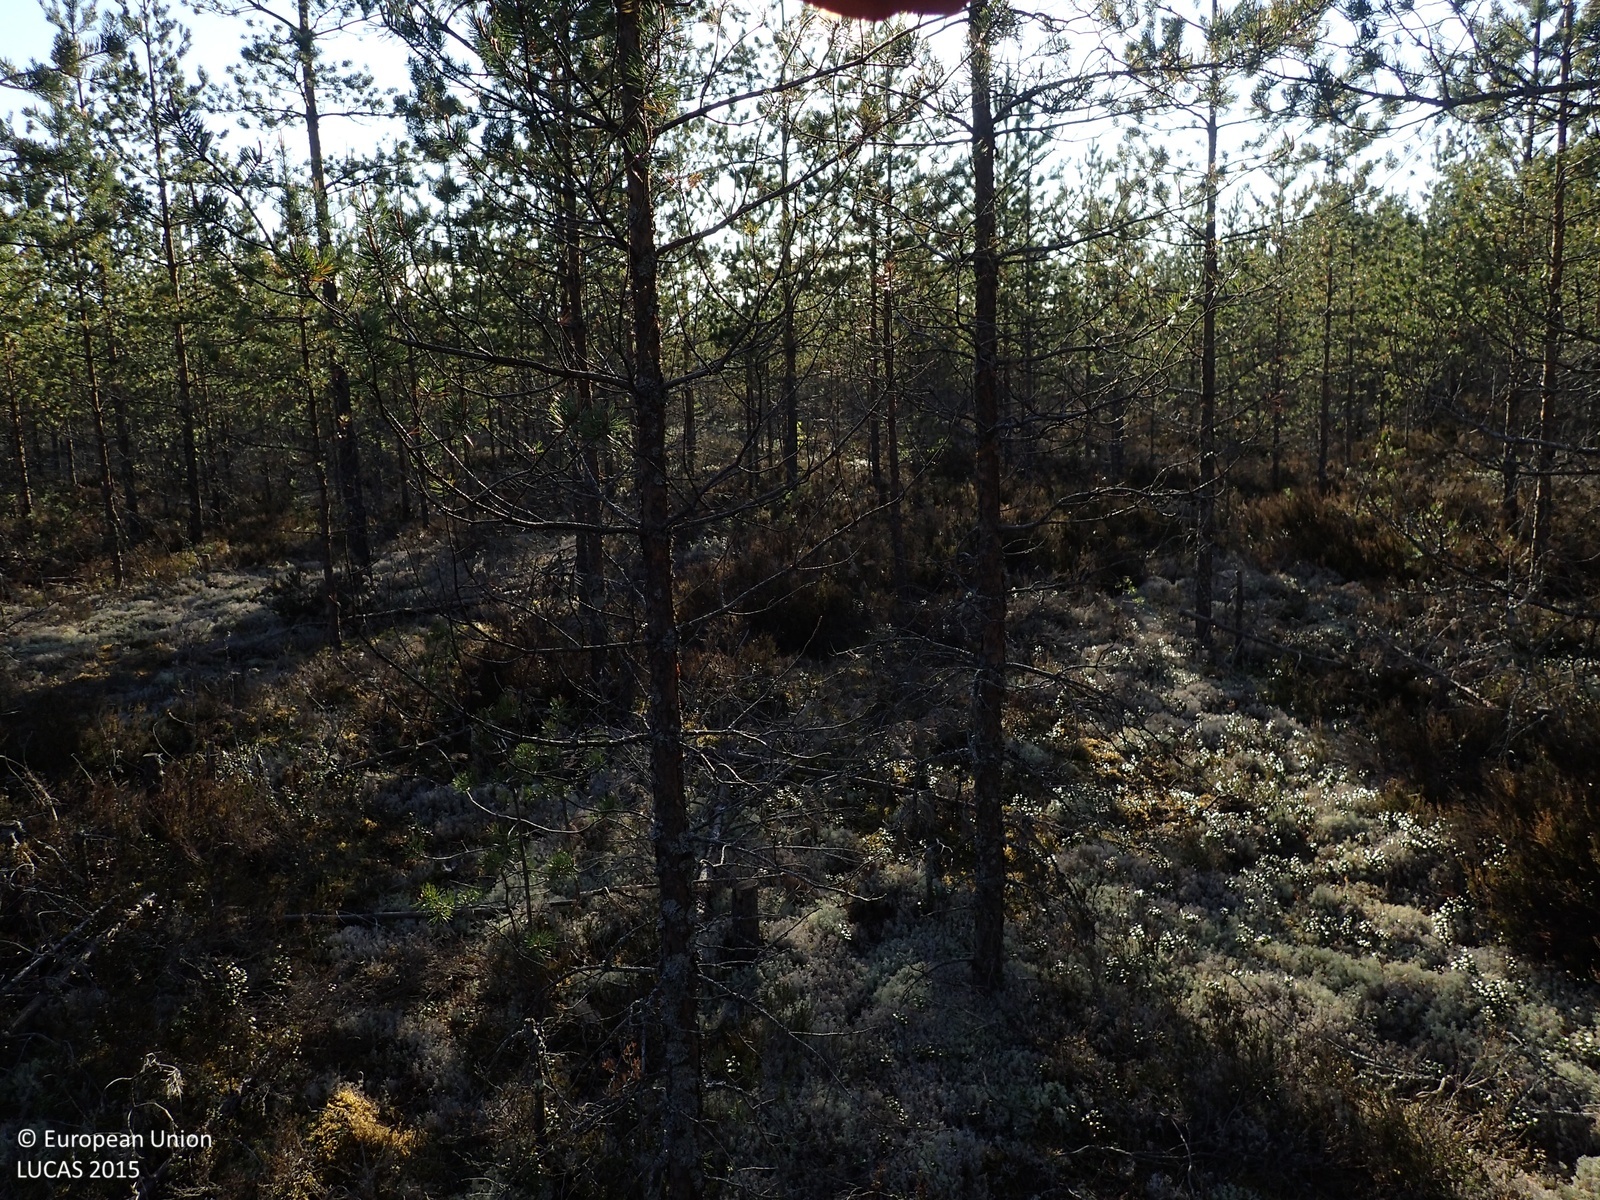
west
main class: Woodland
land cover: Pine dominated coniferous woodland
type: boreal forest
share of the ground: > 75 %
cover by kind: coniferous forest trees 75 %, shrubs 20 %, lichens and mosses 5 %
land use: Forestry
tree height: > 5 m
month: June
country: FI
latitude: 62.3023
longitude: 21.9099
